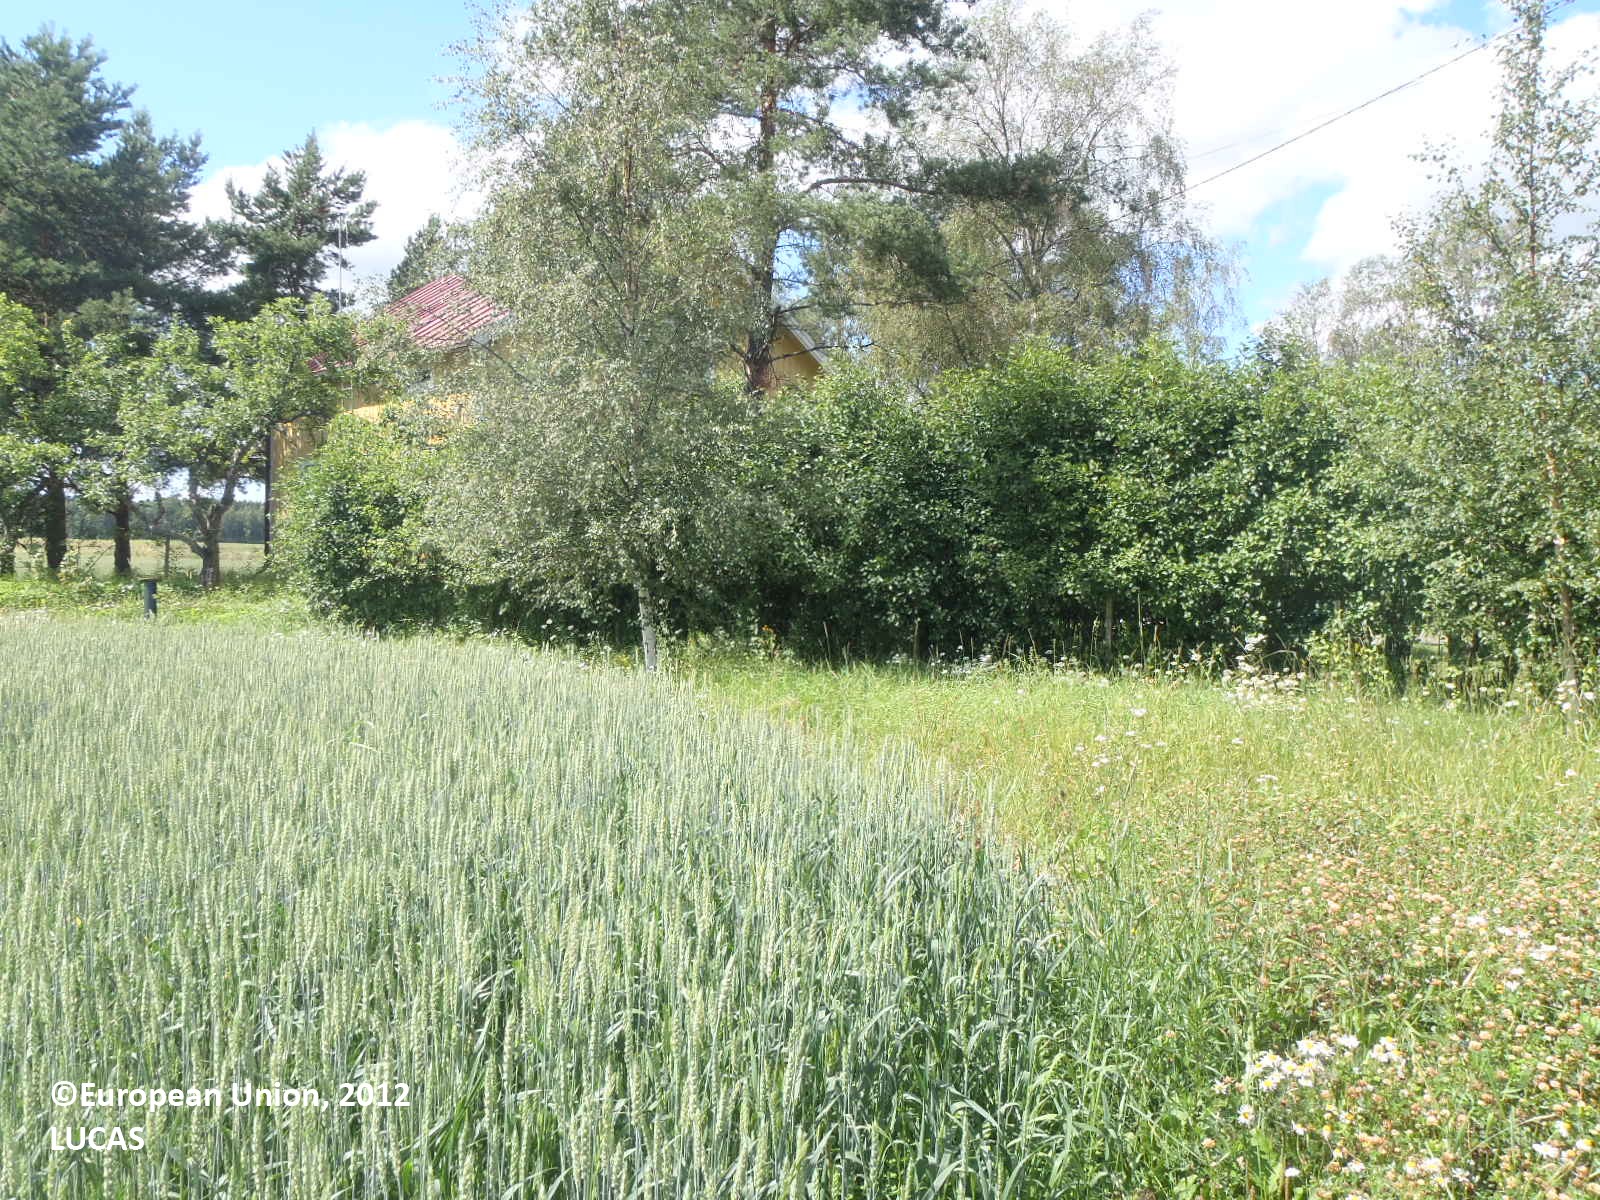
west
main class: Cropland
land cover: Common wheat
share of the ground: > 75 %
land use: Agriculture (excluding fallow land and kitchen gardens)
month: July
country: FI
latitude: 60.6392
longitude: 21.9276
